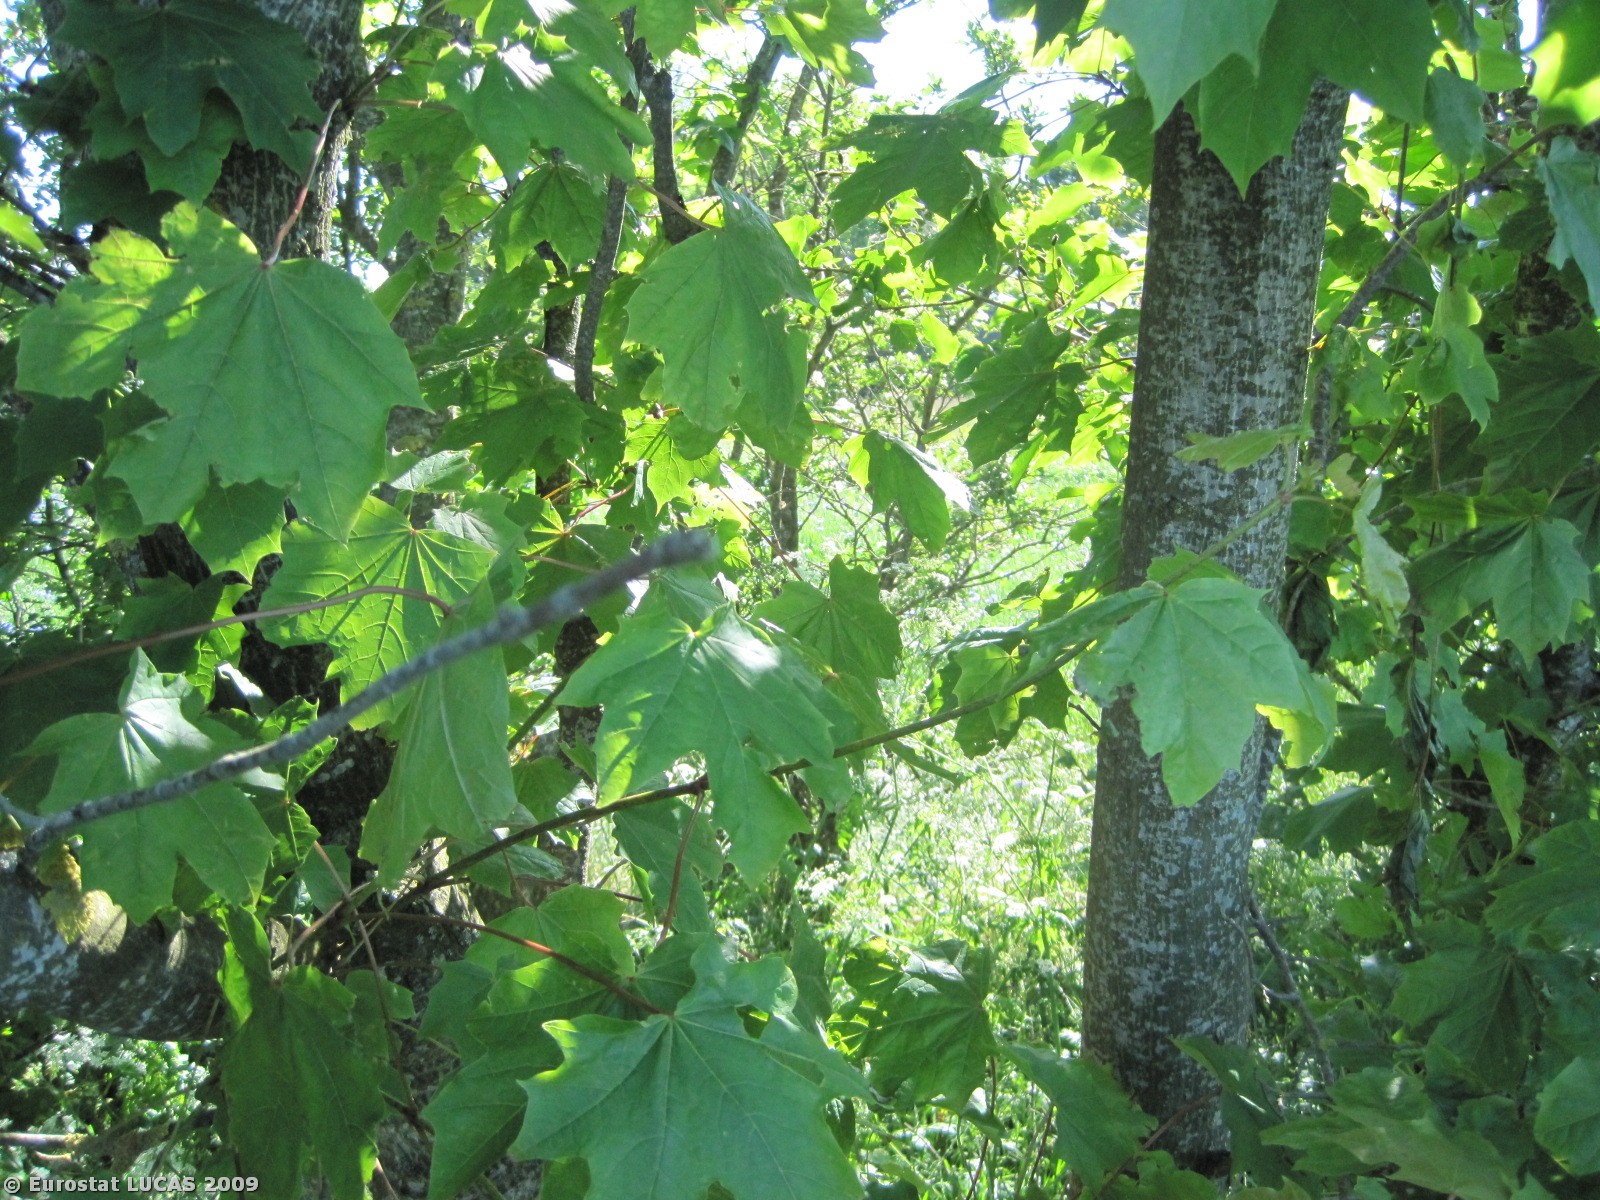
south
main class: Woodland
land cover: Broadleaved woodland
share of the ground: > 75 %
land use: Agriculture (excluding fallow land and kitchen gardens)
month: June
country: DK
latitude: 57.4821
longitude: 10.0500
